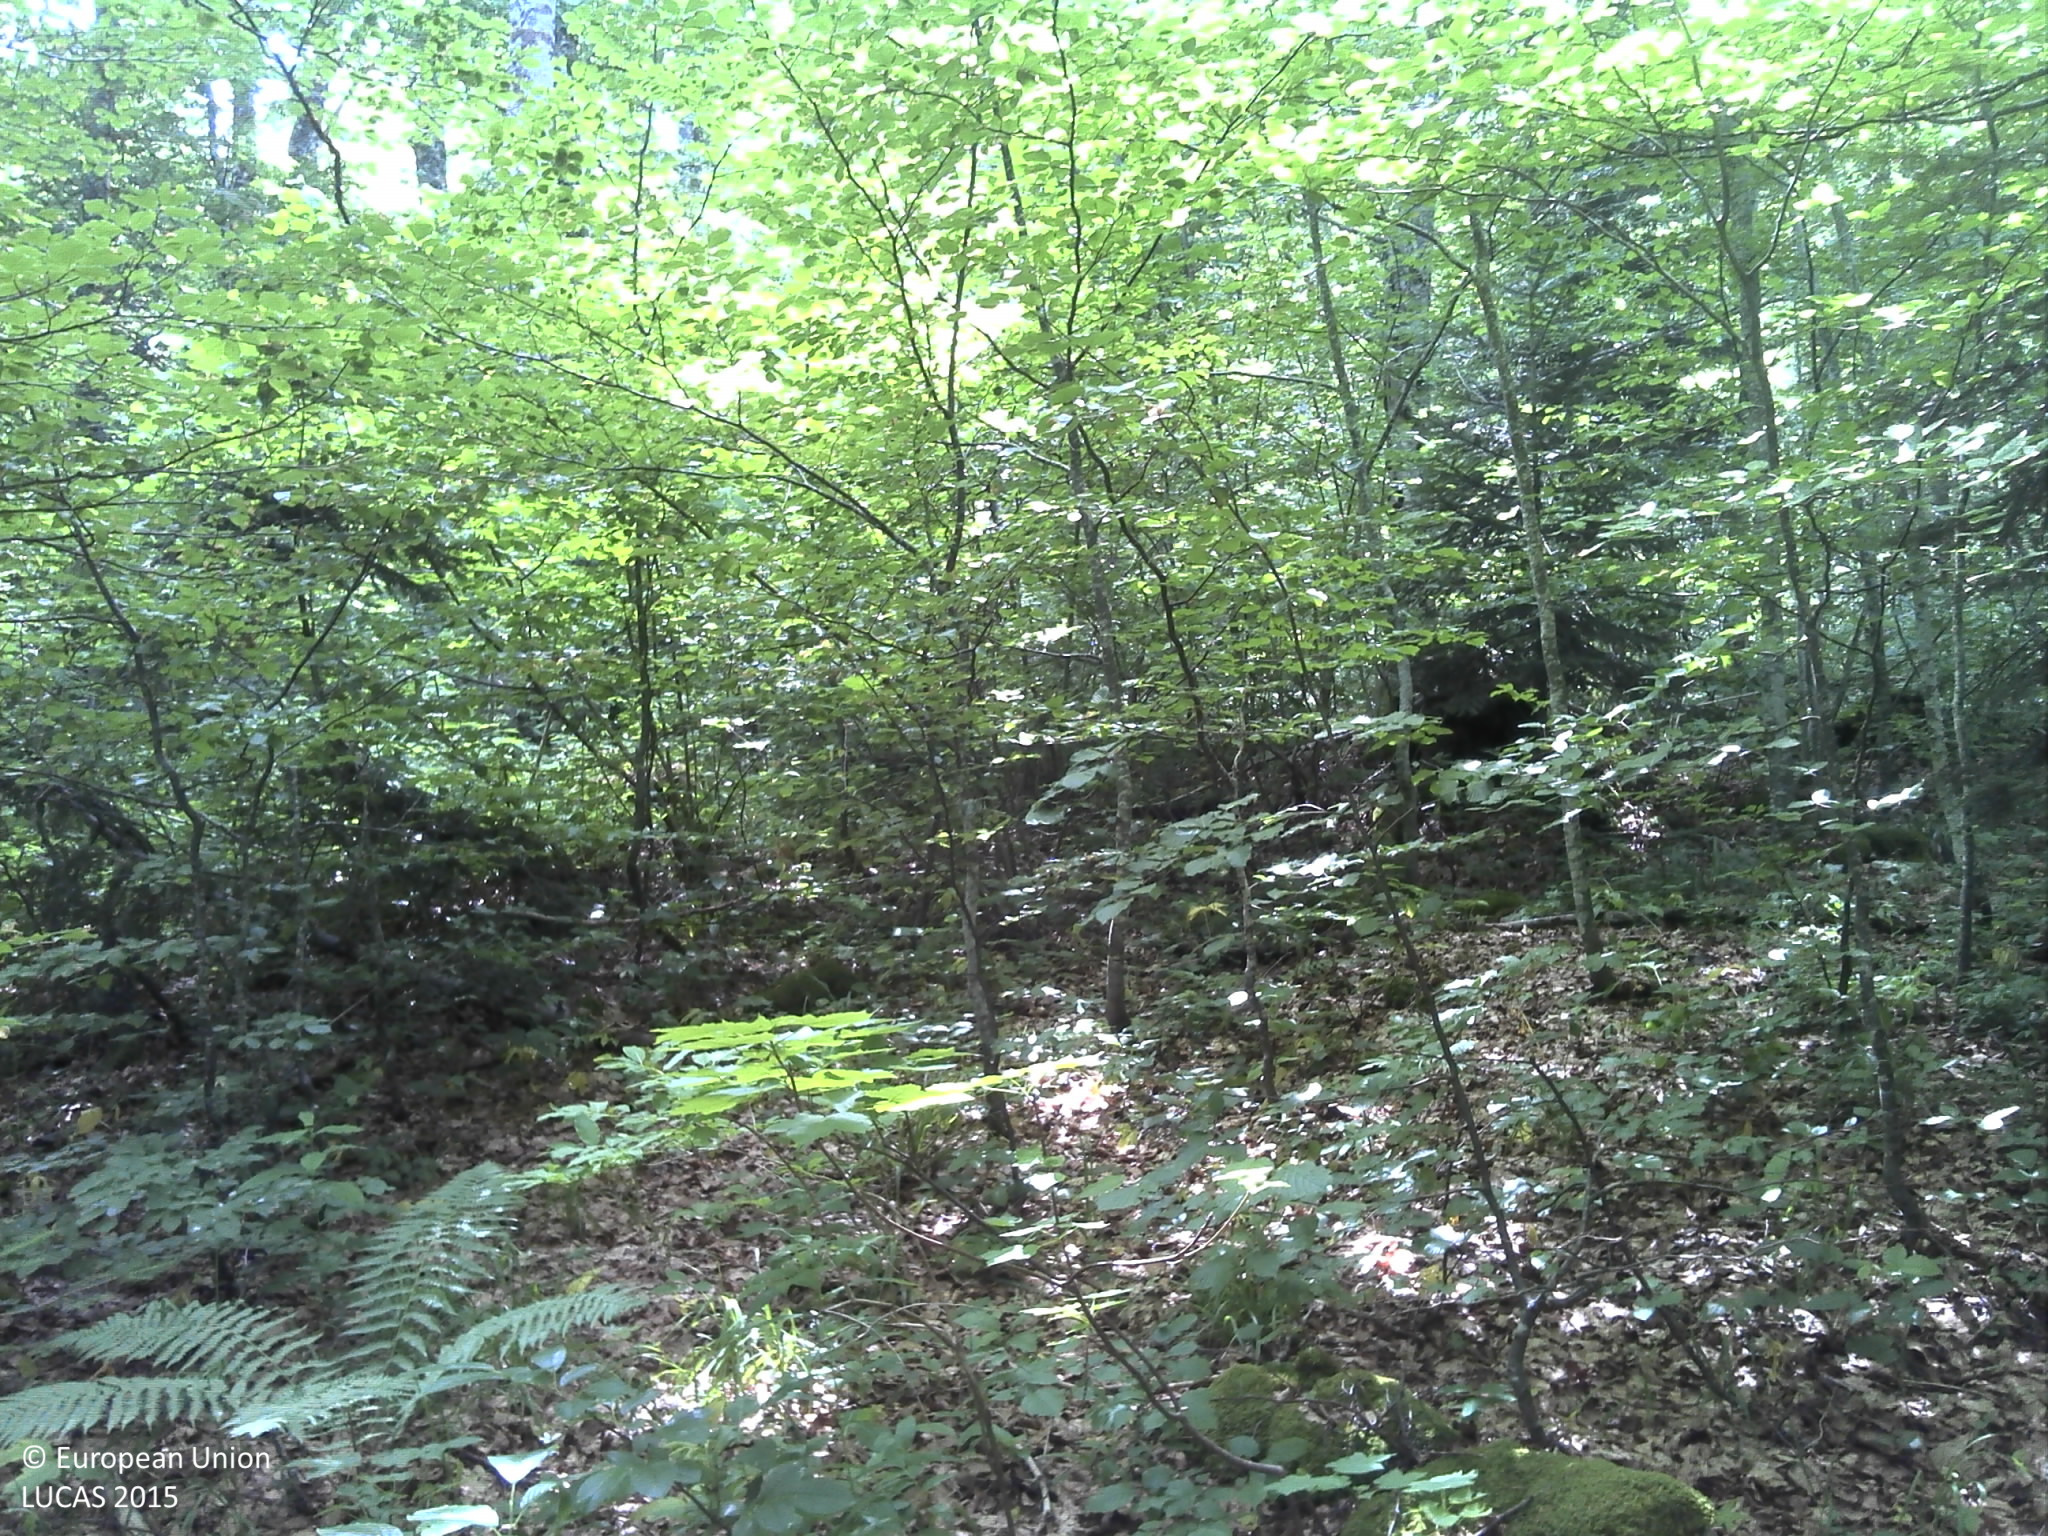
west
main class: Woodland
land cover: Broadleaved woodland
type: mountainous beech forest
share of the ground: > 75 %
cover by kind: broadleaved forest trees 90 %, shrubs 5 %, unconsolidated bare surface 5 %
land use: Forestry
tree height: > 5 m
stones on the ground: < 10 %
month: June
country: HR
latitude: 44.6177
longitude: 15.8794
